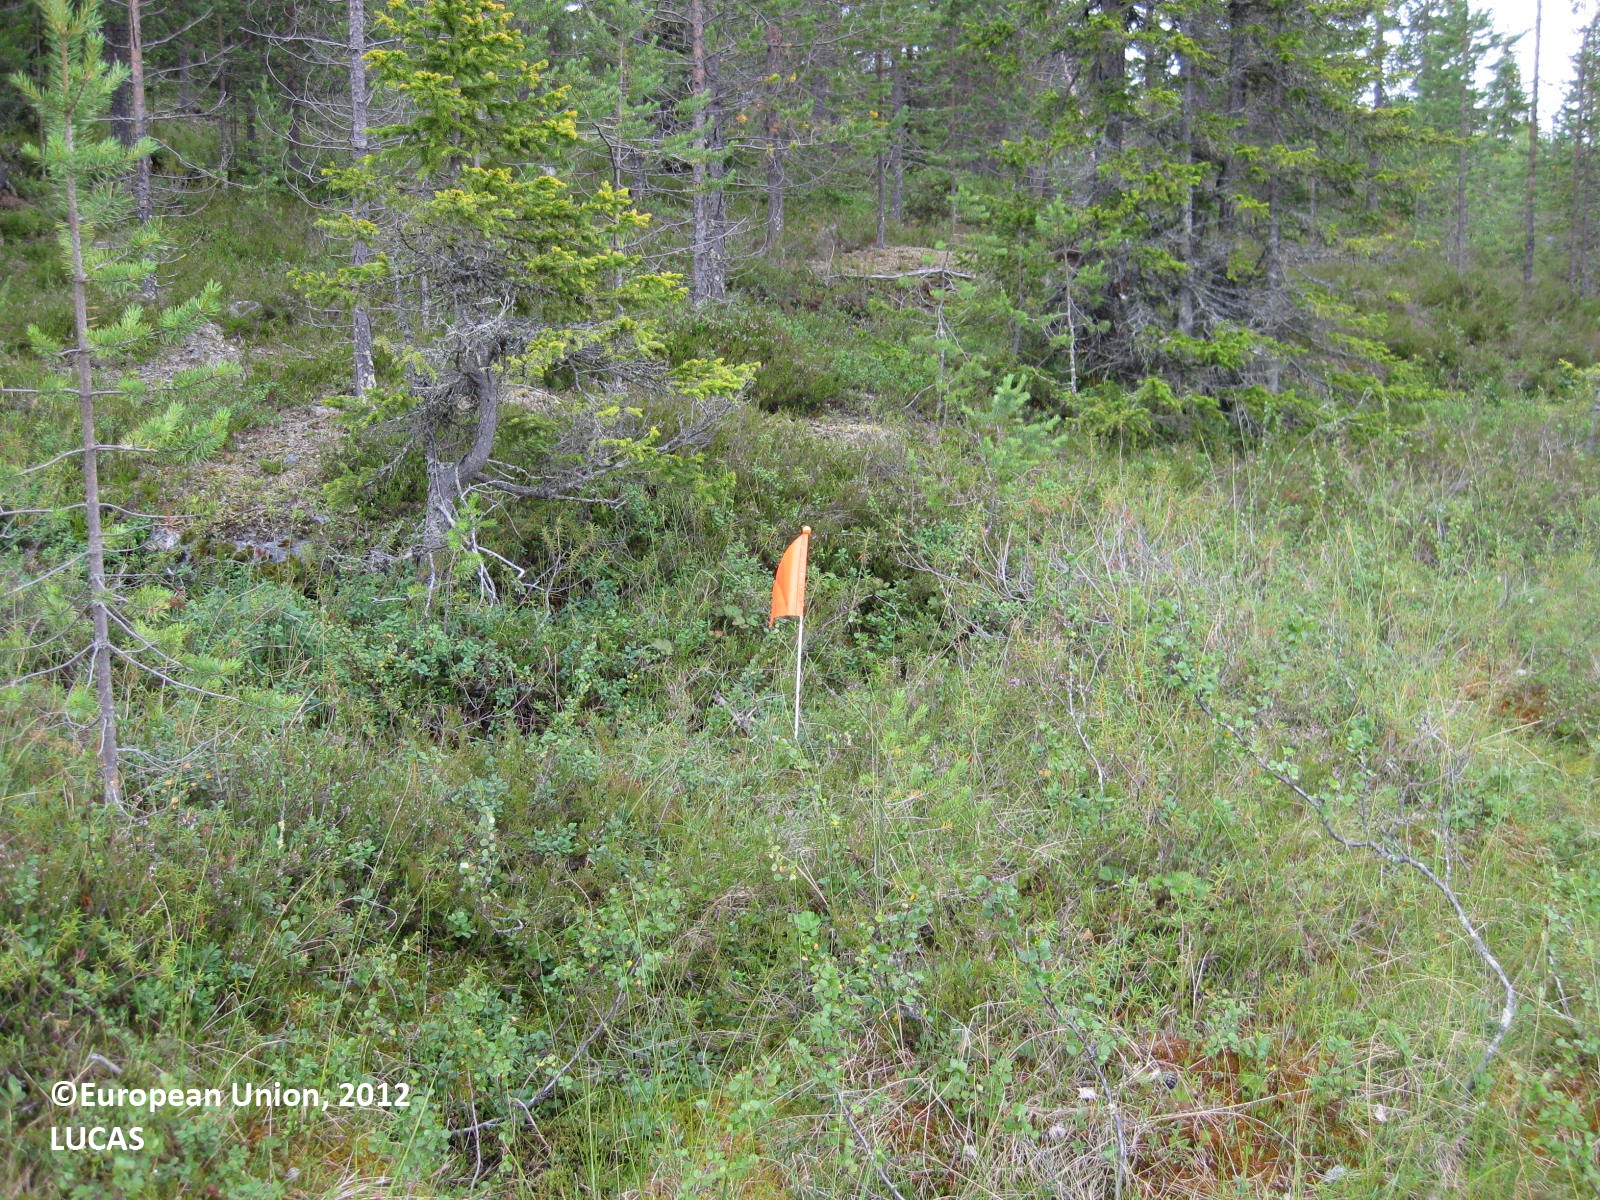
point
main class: Woodland
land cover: Pine dominated coniferous woodland
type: boreal forest
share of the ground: > 75 %
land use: Forestry
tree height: > 5 m
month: July
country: FI
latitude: 65.9254
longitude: 28.5448
